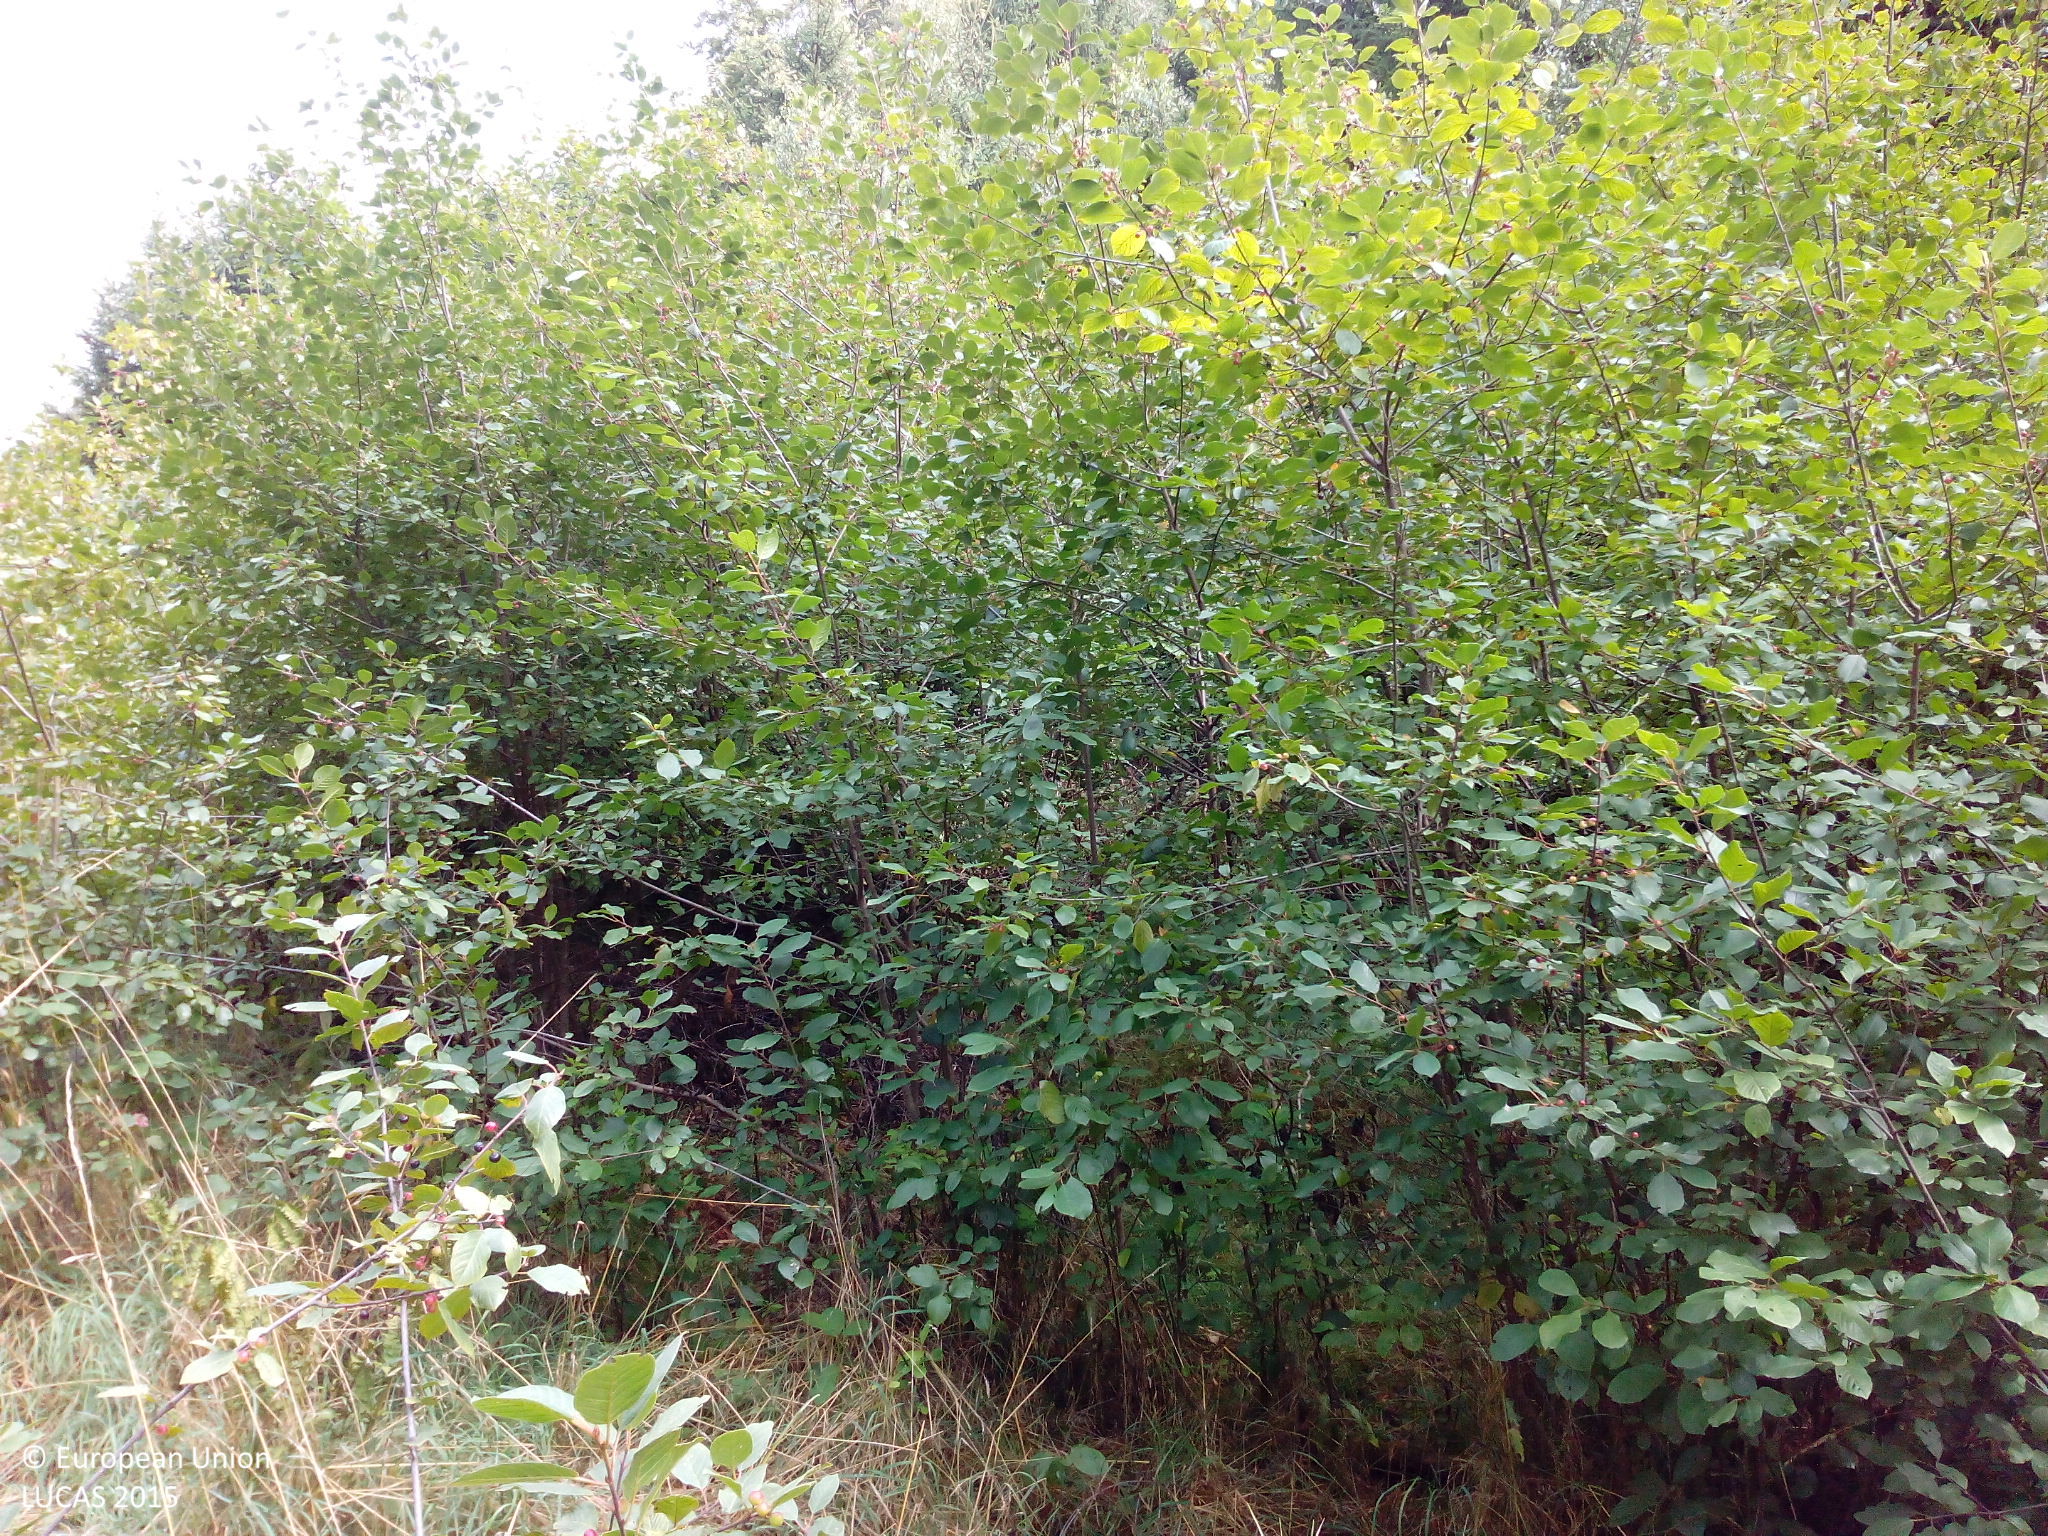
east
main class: Shrubland
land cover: Shrubland with sparse tree cover
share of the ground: > 75 %
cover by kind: shrubs 70 %, herbaceous plants 25 %, broadleaved forest trees 5 %
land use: Forestry
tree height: < 5 m
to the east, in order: Shrubland with sparse tree cover; Broadleaved woodland; Spruce dominated mixed woodland; Tracks; Pine dominated mixed woodland; Grassland without tree/shrub cover
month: August
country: DE
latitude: 50.0861
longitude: 7.5545
